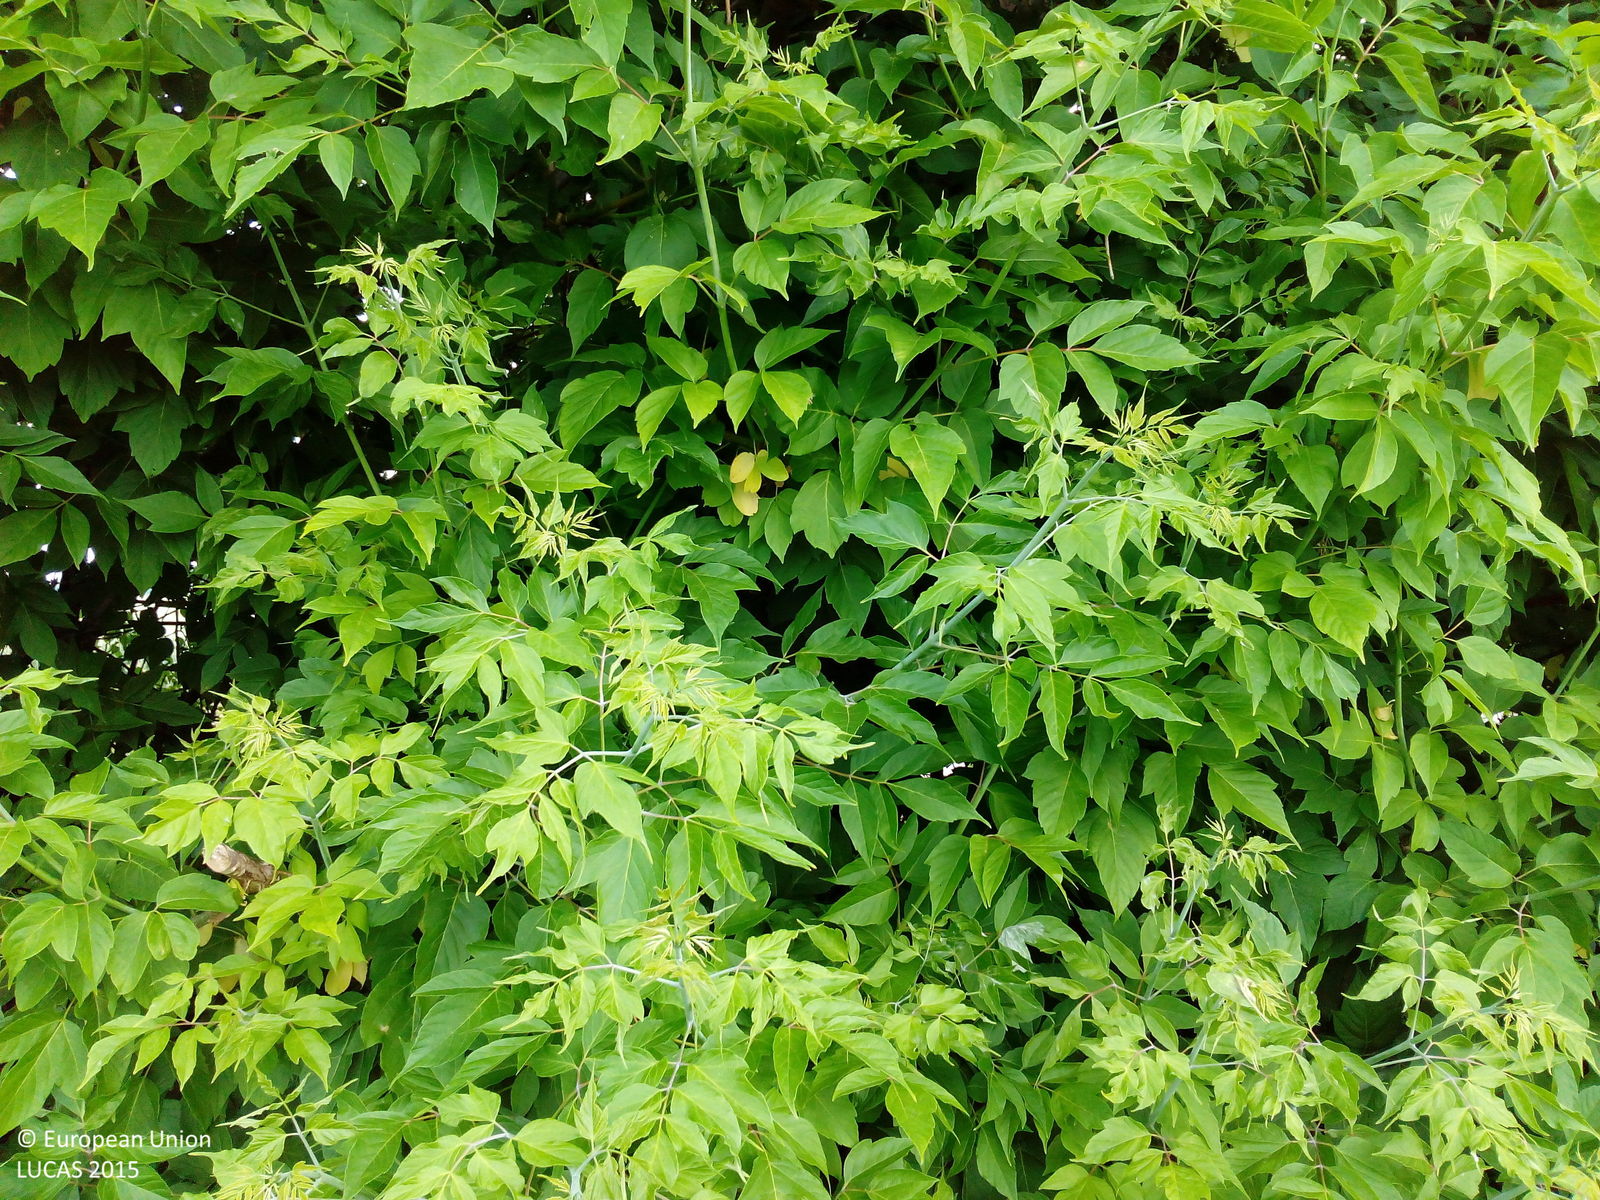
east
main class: Cropland
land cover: Dry pulses
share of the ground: > 75 %
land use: Agriculture (excluding fallow land and kitchen gardens)
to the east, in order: Dry pulses; Broadleaved woodland; Paved roads, cycling and walking lanes; Grass margins; Common wheat
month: June
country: DE
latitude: 51.8868
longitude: 11.1184
